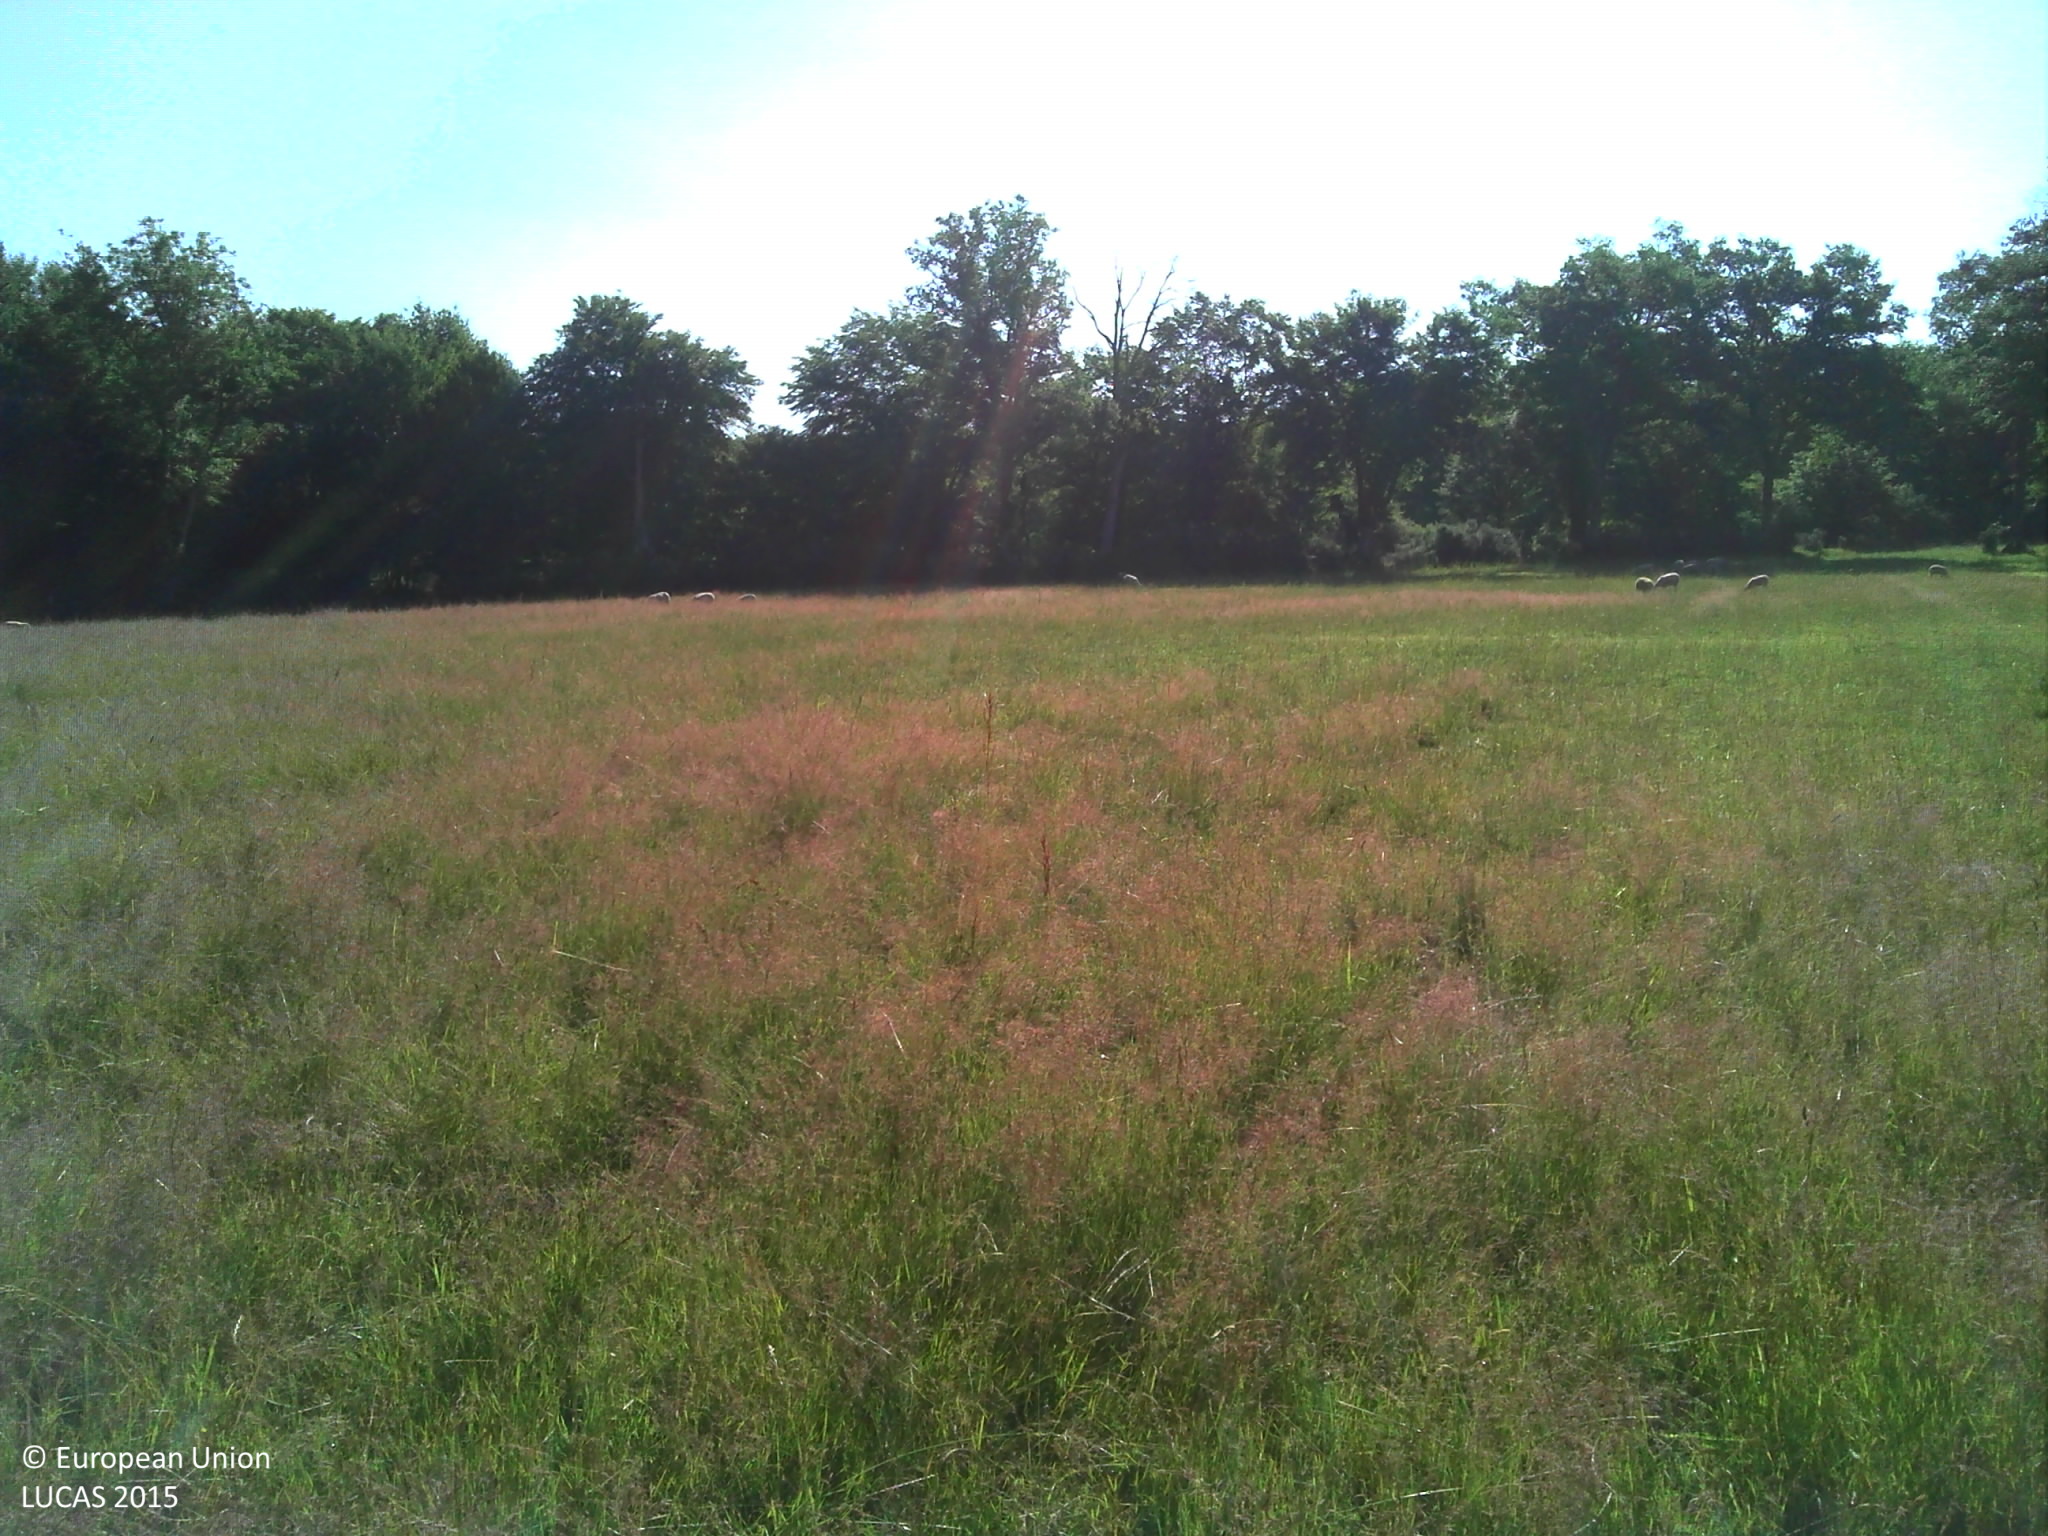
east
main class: Grassland
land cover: Grassland without tree/shrub cover
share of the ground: > 75 %
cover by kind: herbaceous plants 100 %
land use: Agriculture (excluding fallow land and kitchen gardens)
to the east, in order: Grassland without tree/shrub cover; Single bushes/trees; Grassland without tree/shrub cover; Fences; Shrubland without tree cover; Fences; Grassland without tree/shrub cover; Fences; Broadleaved woodland; Grassland without tree/shrub cover; Fences; Broadleaved woodland
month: June
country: FR
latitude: 45.9217
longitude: 0.6378
